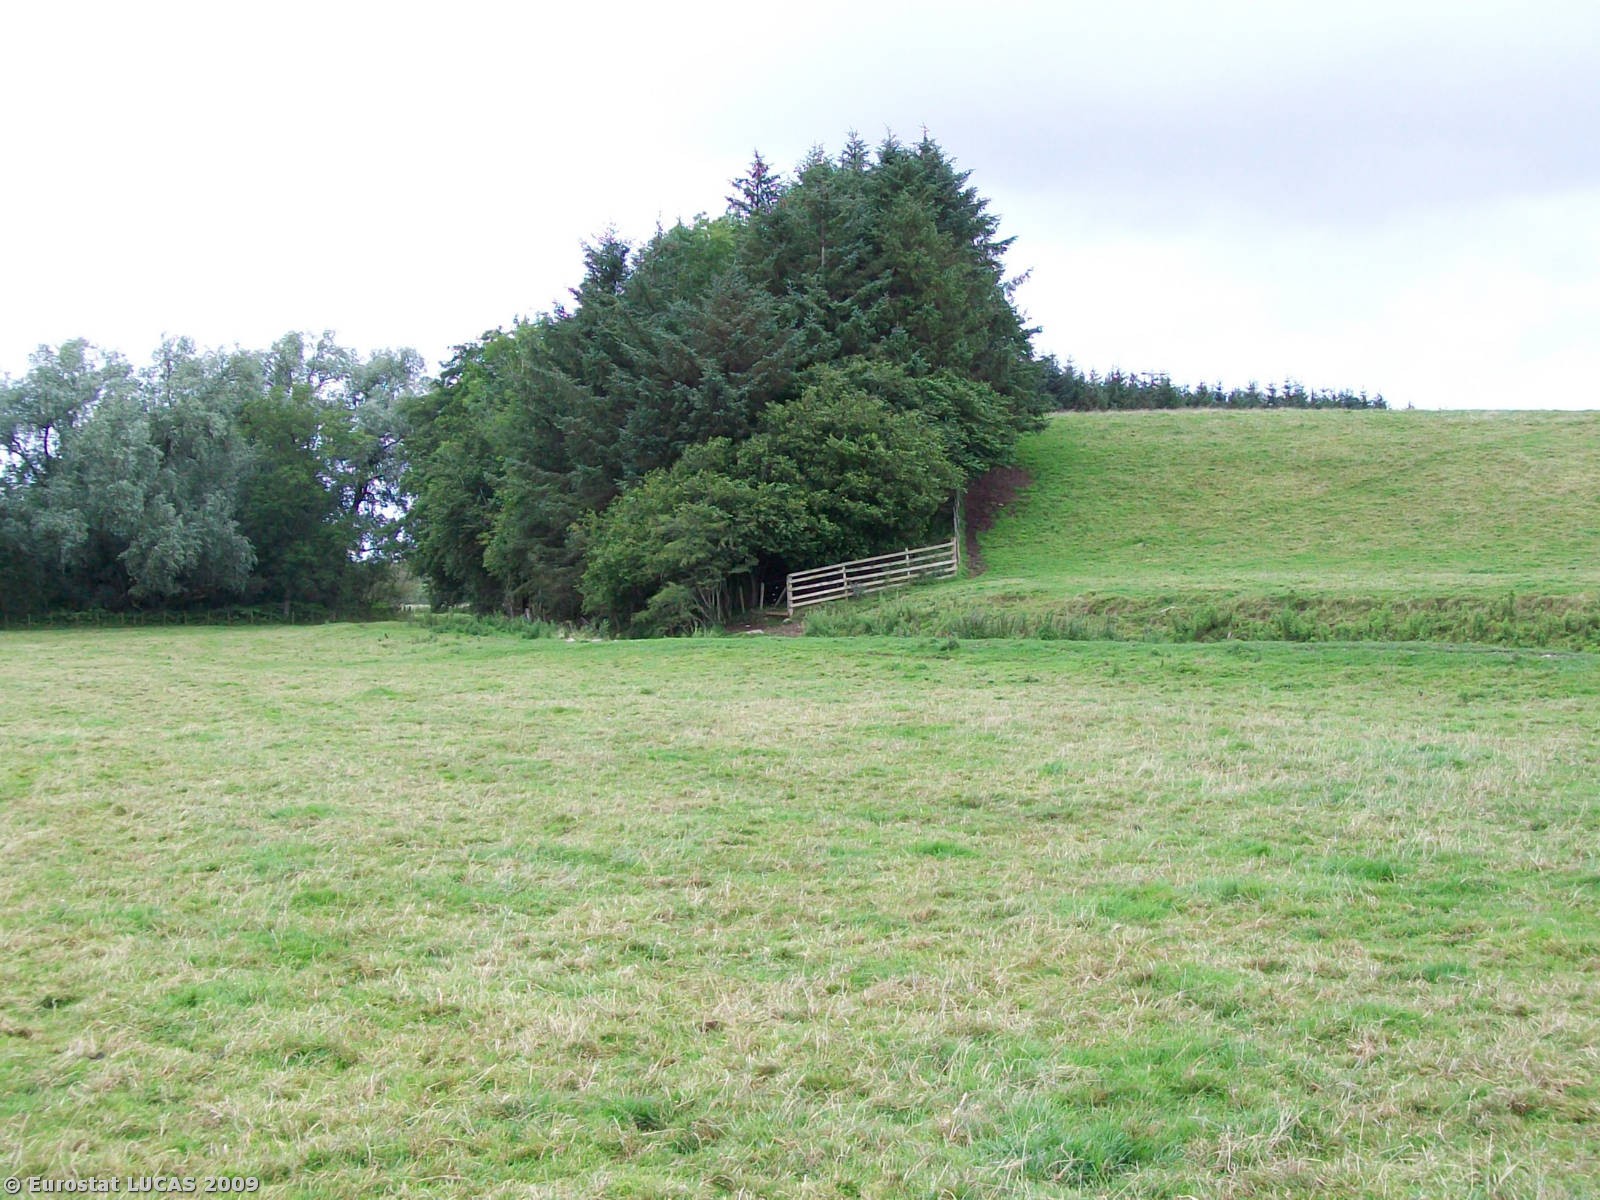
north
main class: Grassland
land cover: Grassland without tree/shrub cover
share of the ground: > 75 %
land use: Agriculture (excluding fallow land and kitchen gardens)
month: July
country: GB
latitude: 55.0496
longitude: -3.3348
